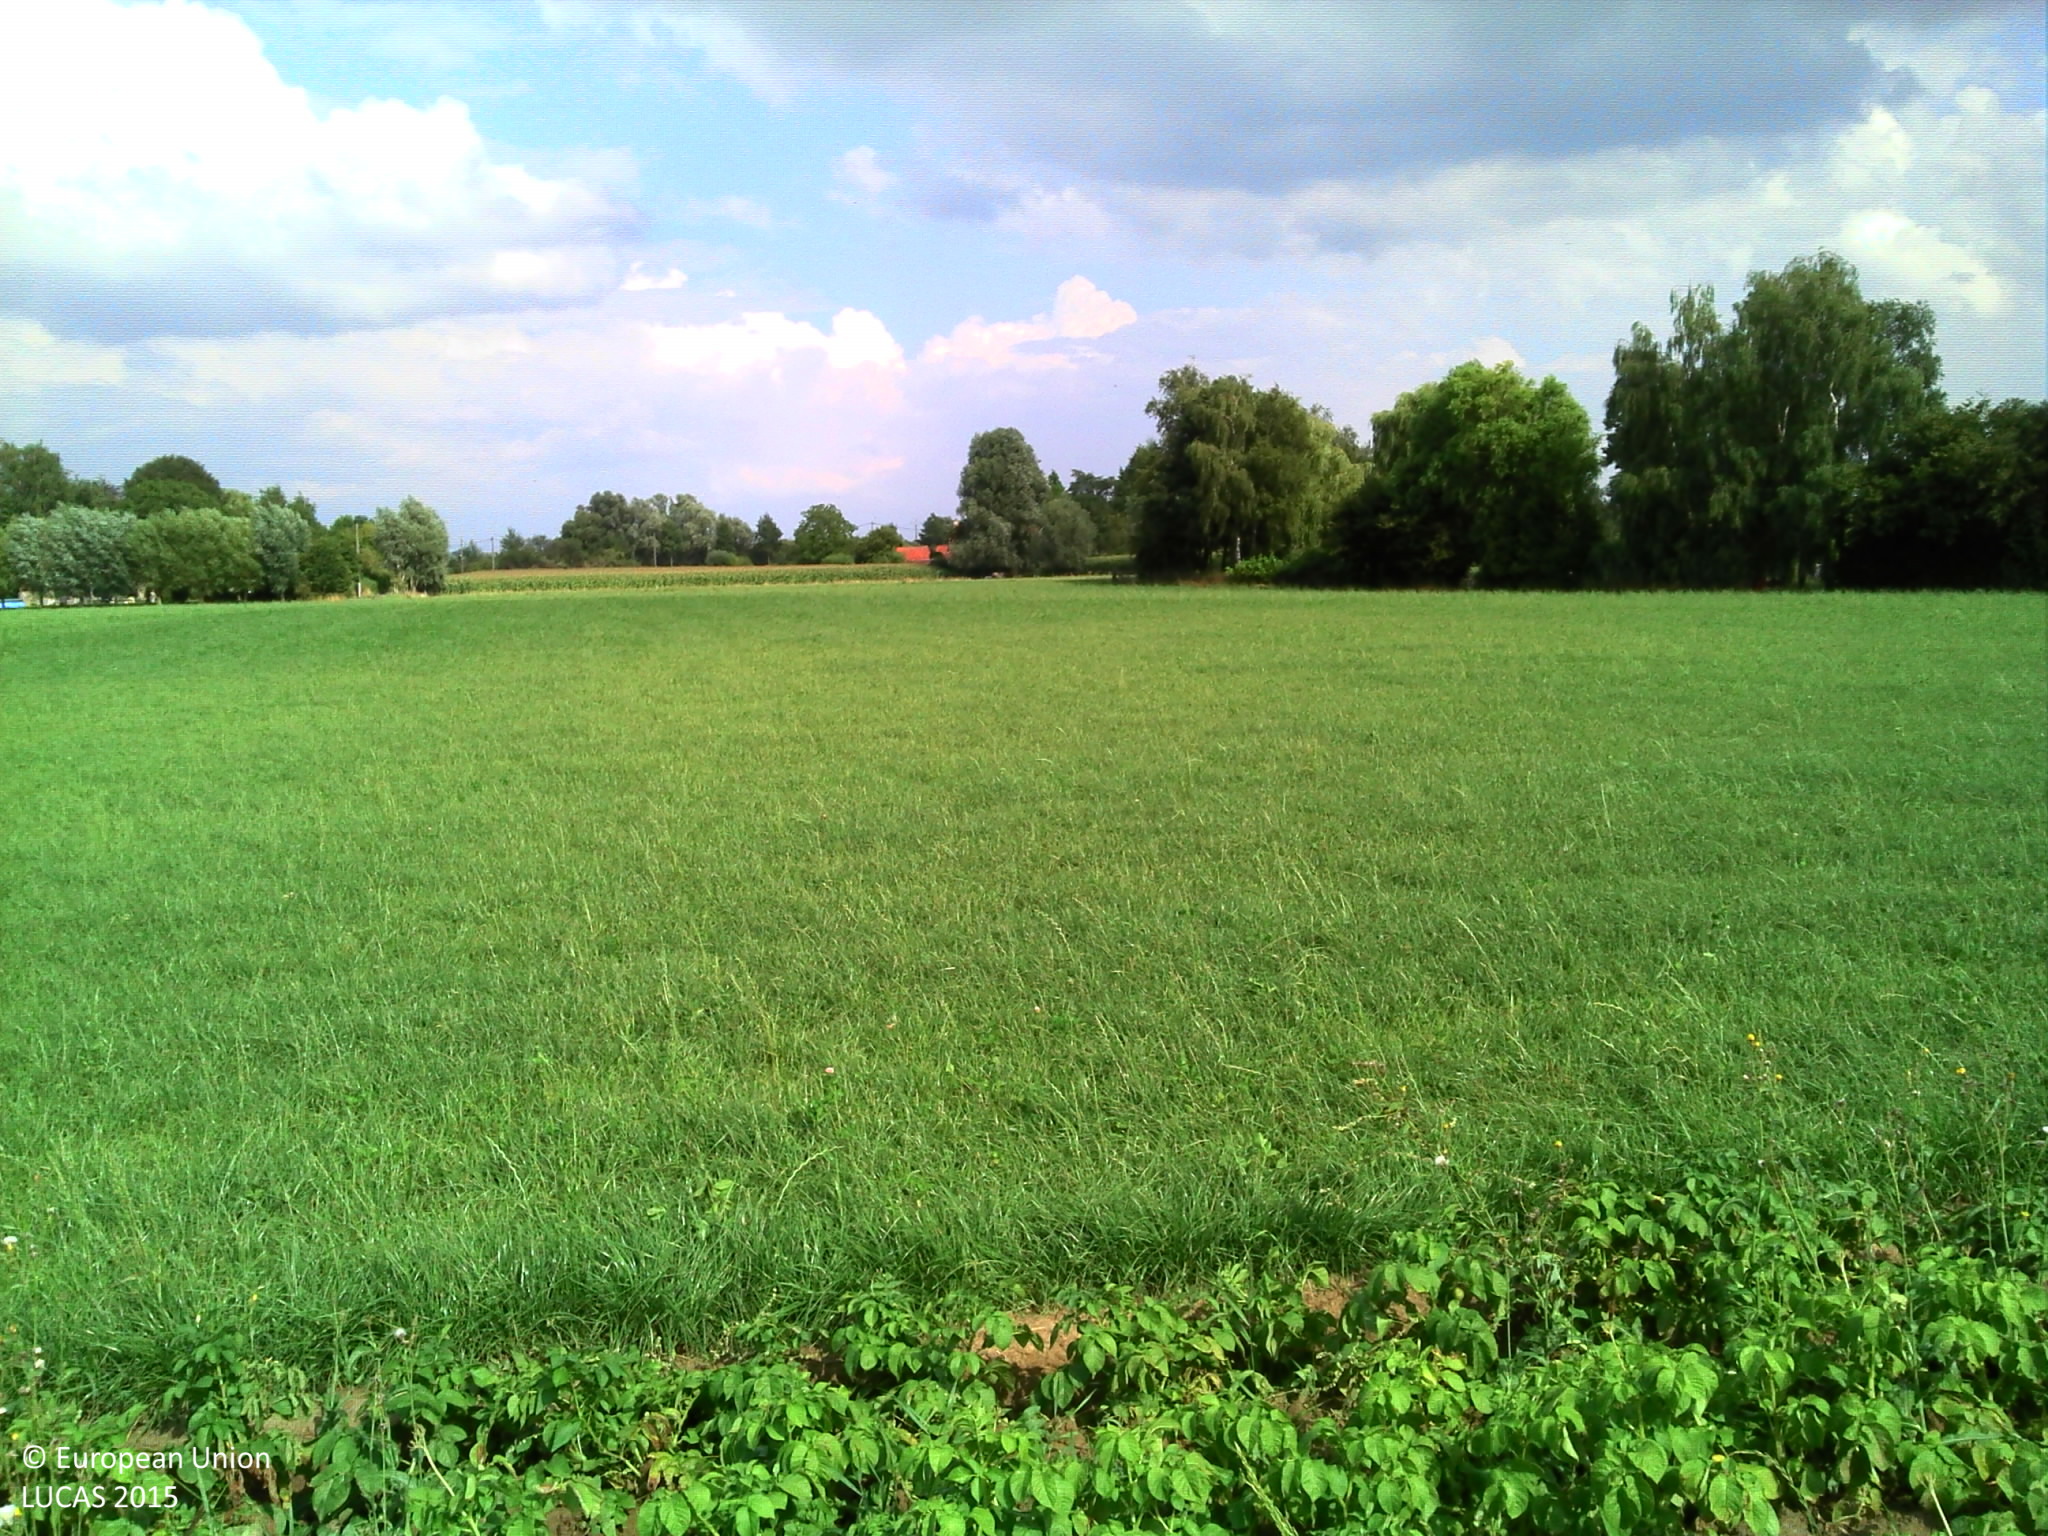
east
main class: Cropland
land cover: Potatoes
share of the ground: > 75 %
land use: Agriculture (excluding fallow land and kitchen gardens)
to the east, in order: Potatoes; Temporary grasslands; Ditches and canals; Fences; Grassland without tree/shrub cover
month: August
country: BE
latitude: 50.7794
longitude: 2.9695
